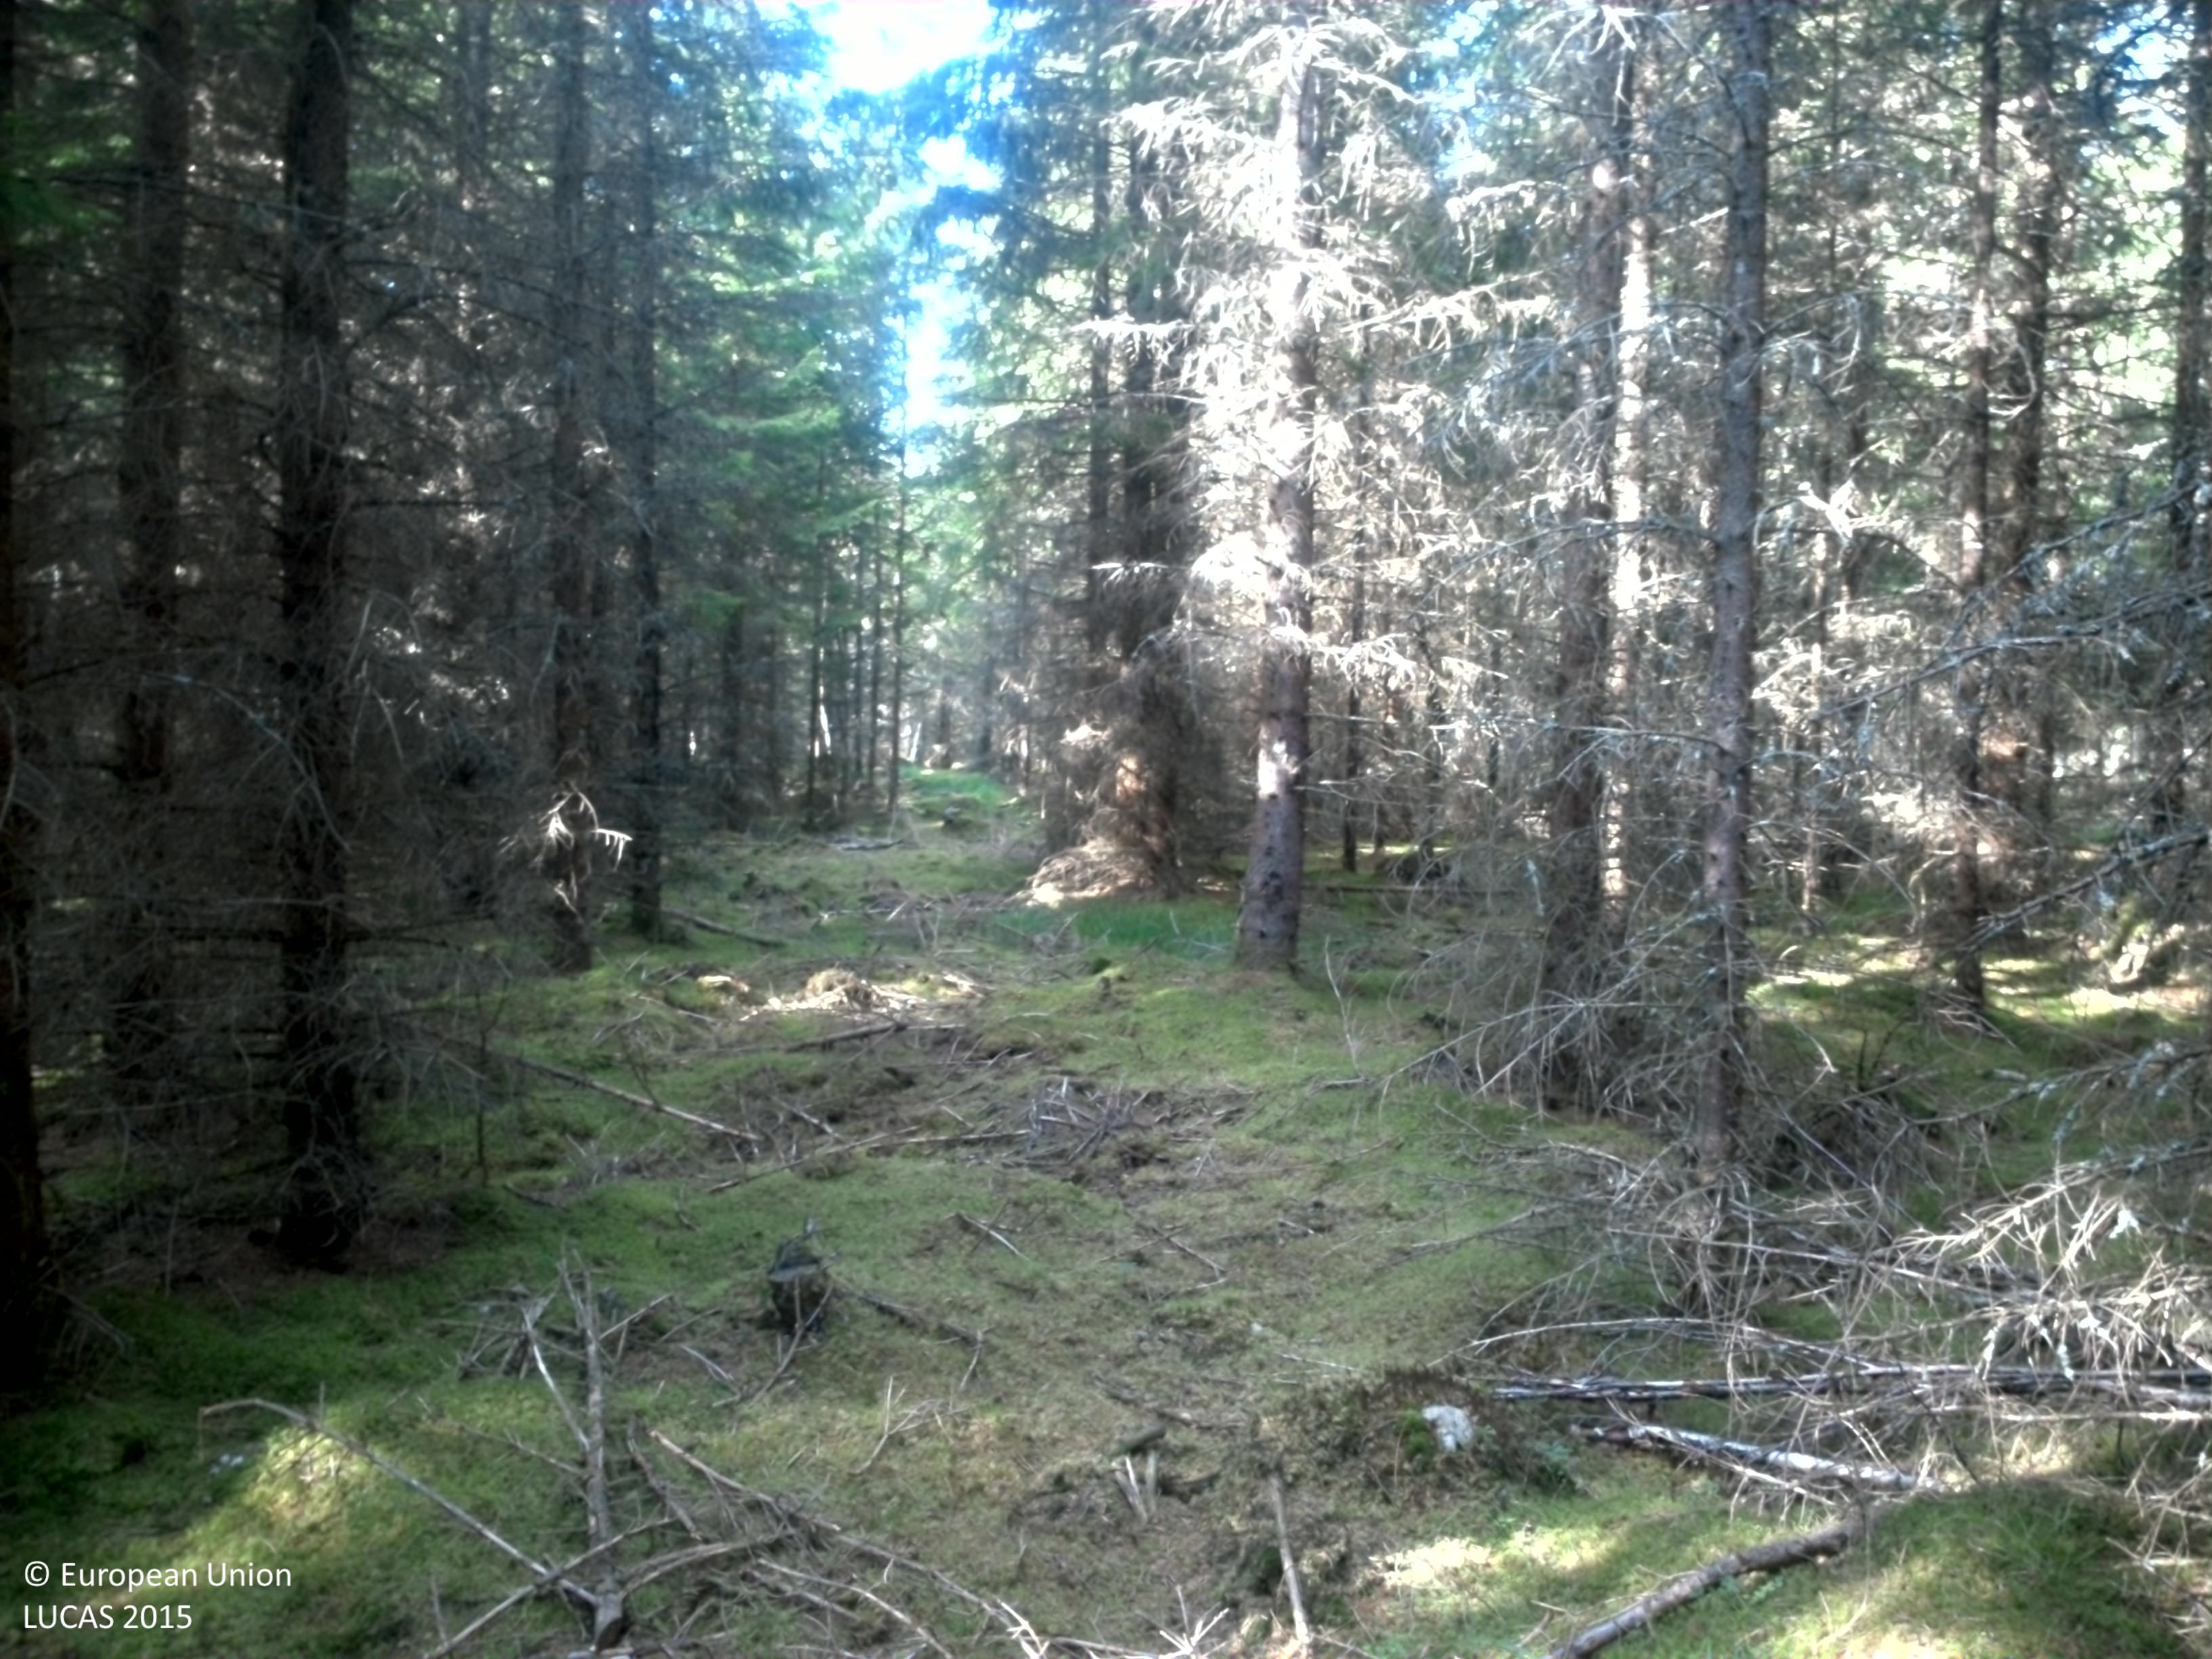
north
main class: Woodland
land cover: Spruce dominated coniferous woodland
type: boreal forest
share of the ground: 50 - 75 %
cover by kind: coniferous forest trees 70 %, lichens and mosses 25 %, herbaceous plants 5 %
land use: Forestry
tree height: > 5 m
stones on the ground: < 10 %
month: August
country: SE
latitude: 58.1608
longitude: 13.3087
